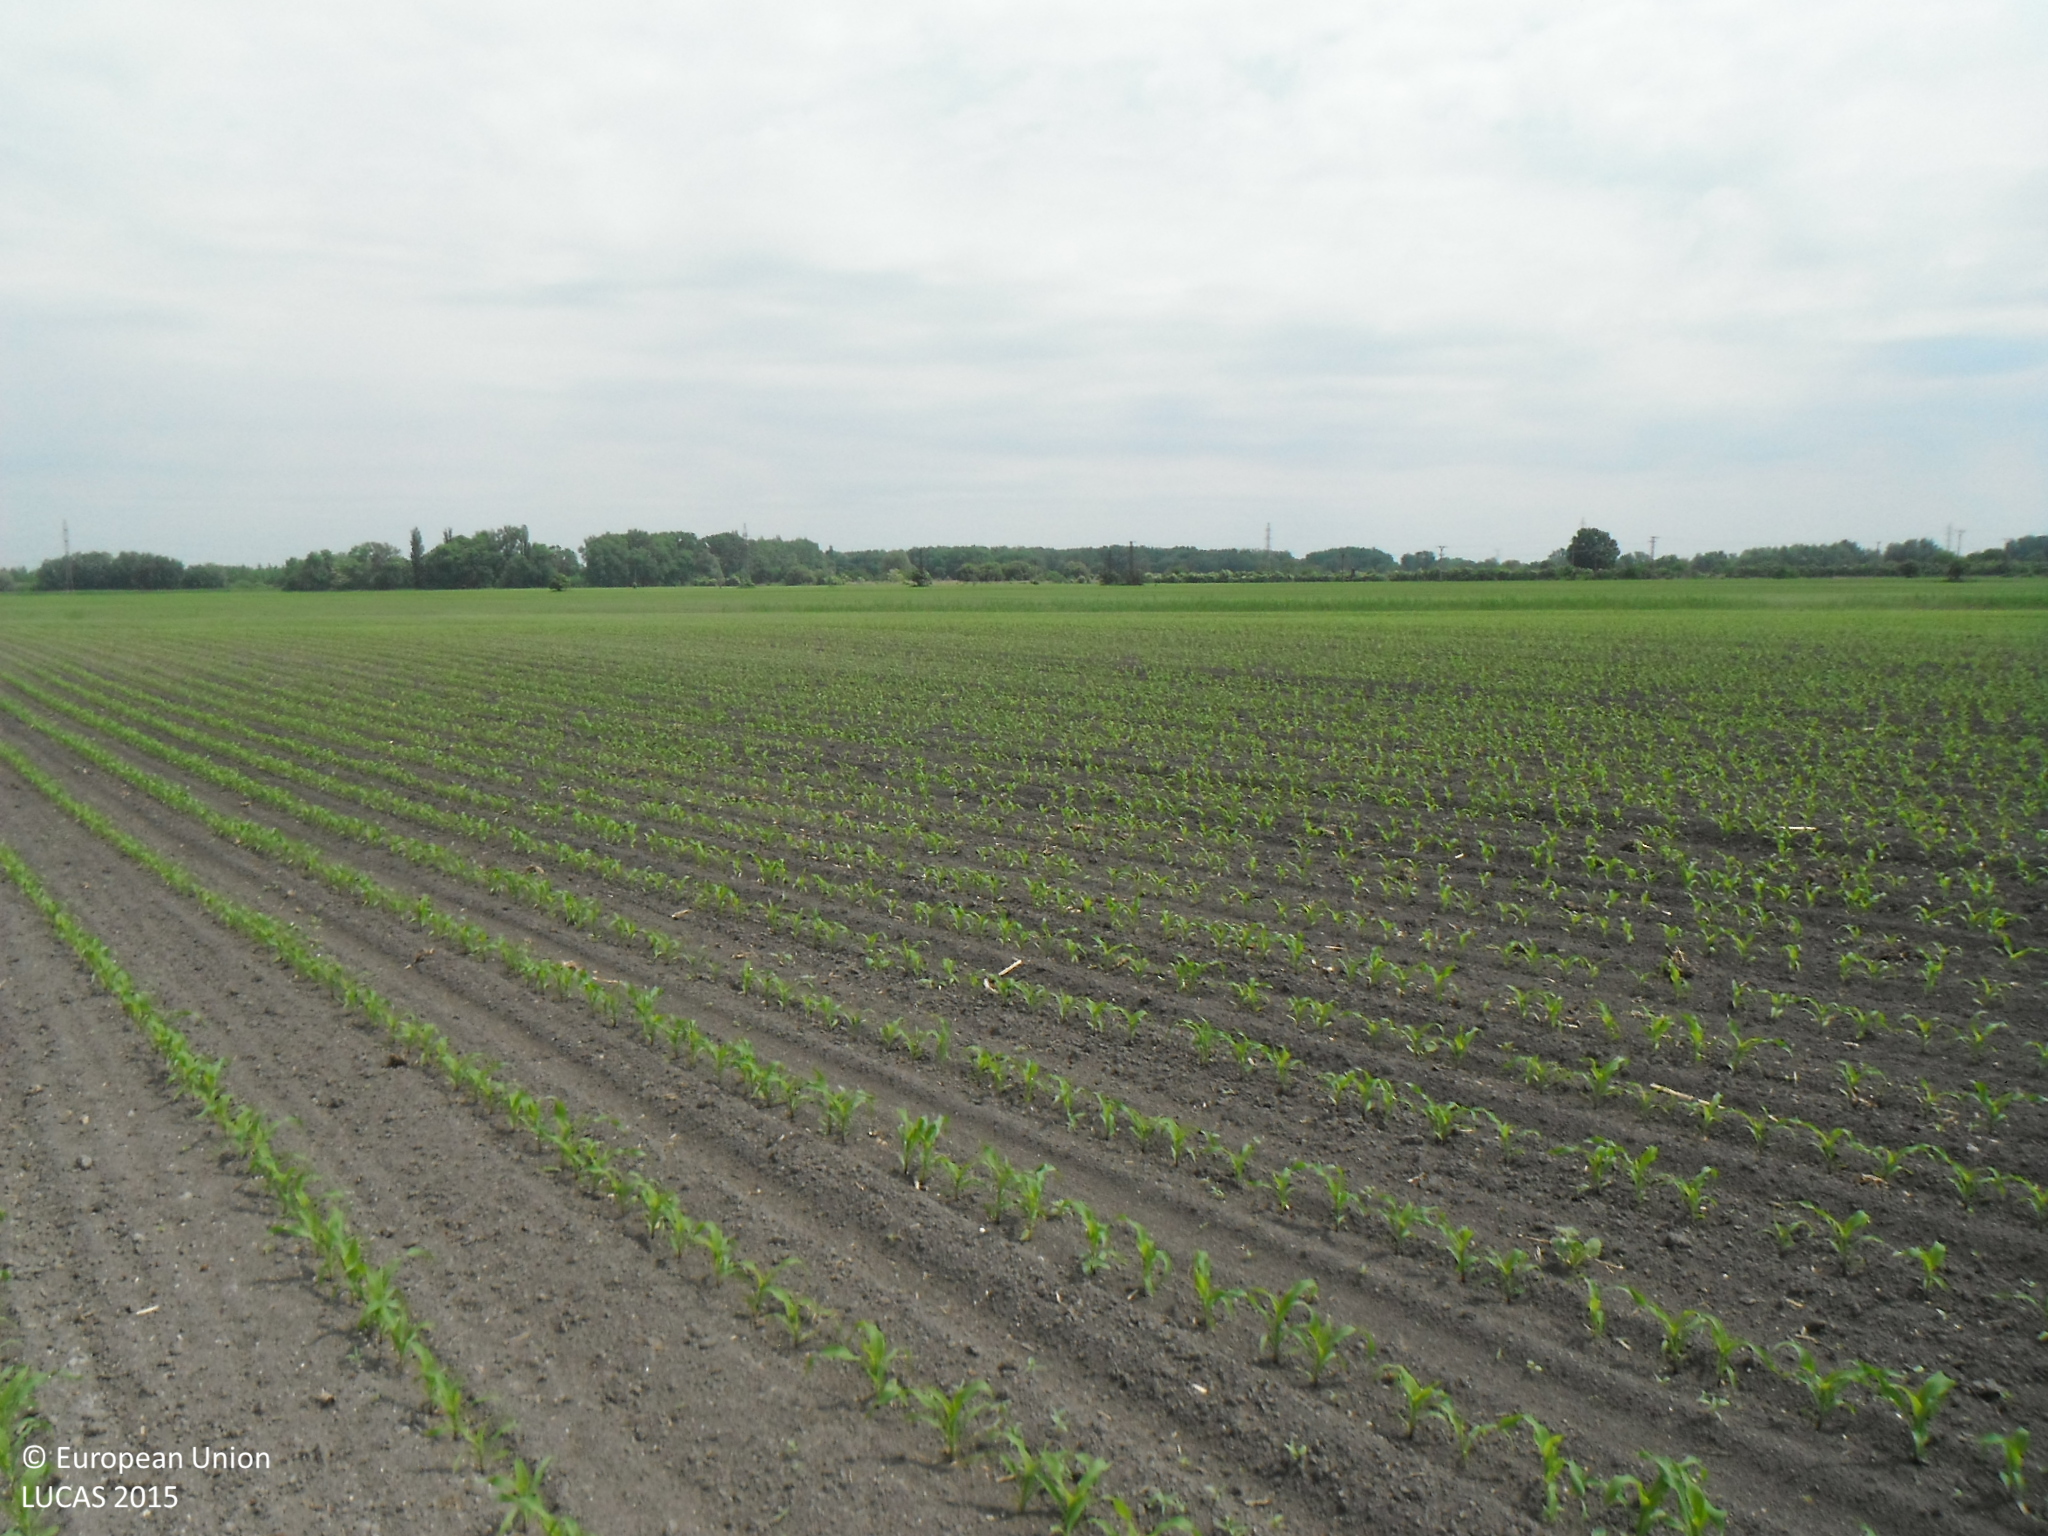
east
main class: Cropland
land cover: Maize
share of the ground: < 10 %
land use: Agriculture (excluding fallow land and kitchen gardens)
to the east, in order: Maize
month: May
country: SK
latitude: 47.8978
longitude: 17.7285
